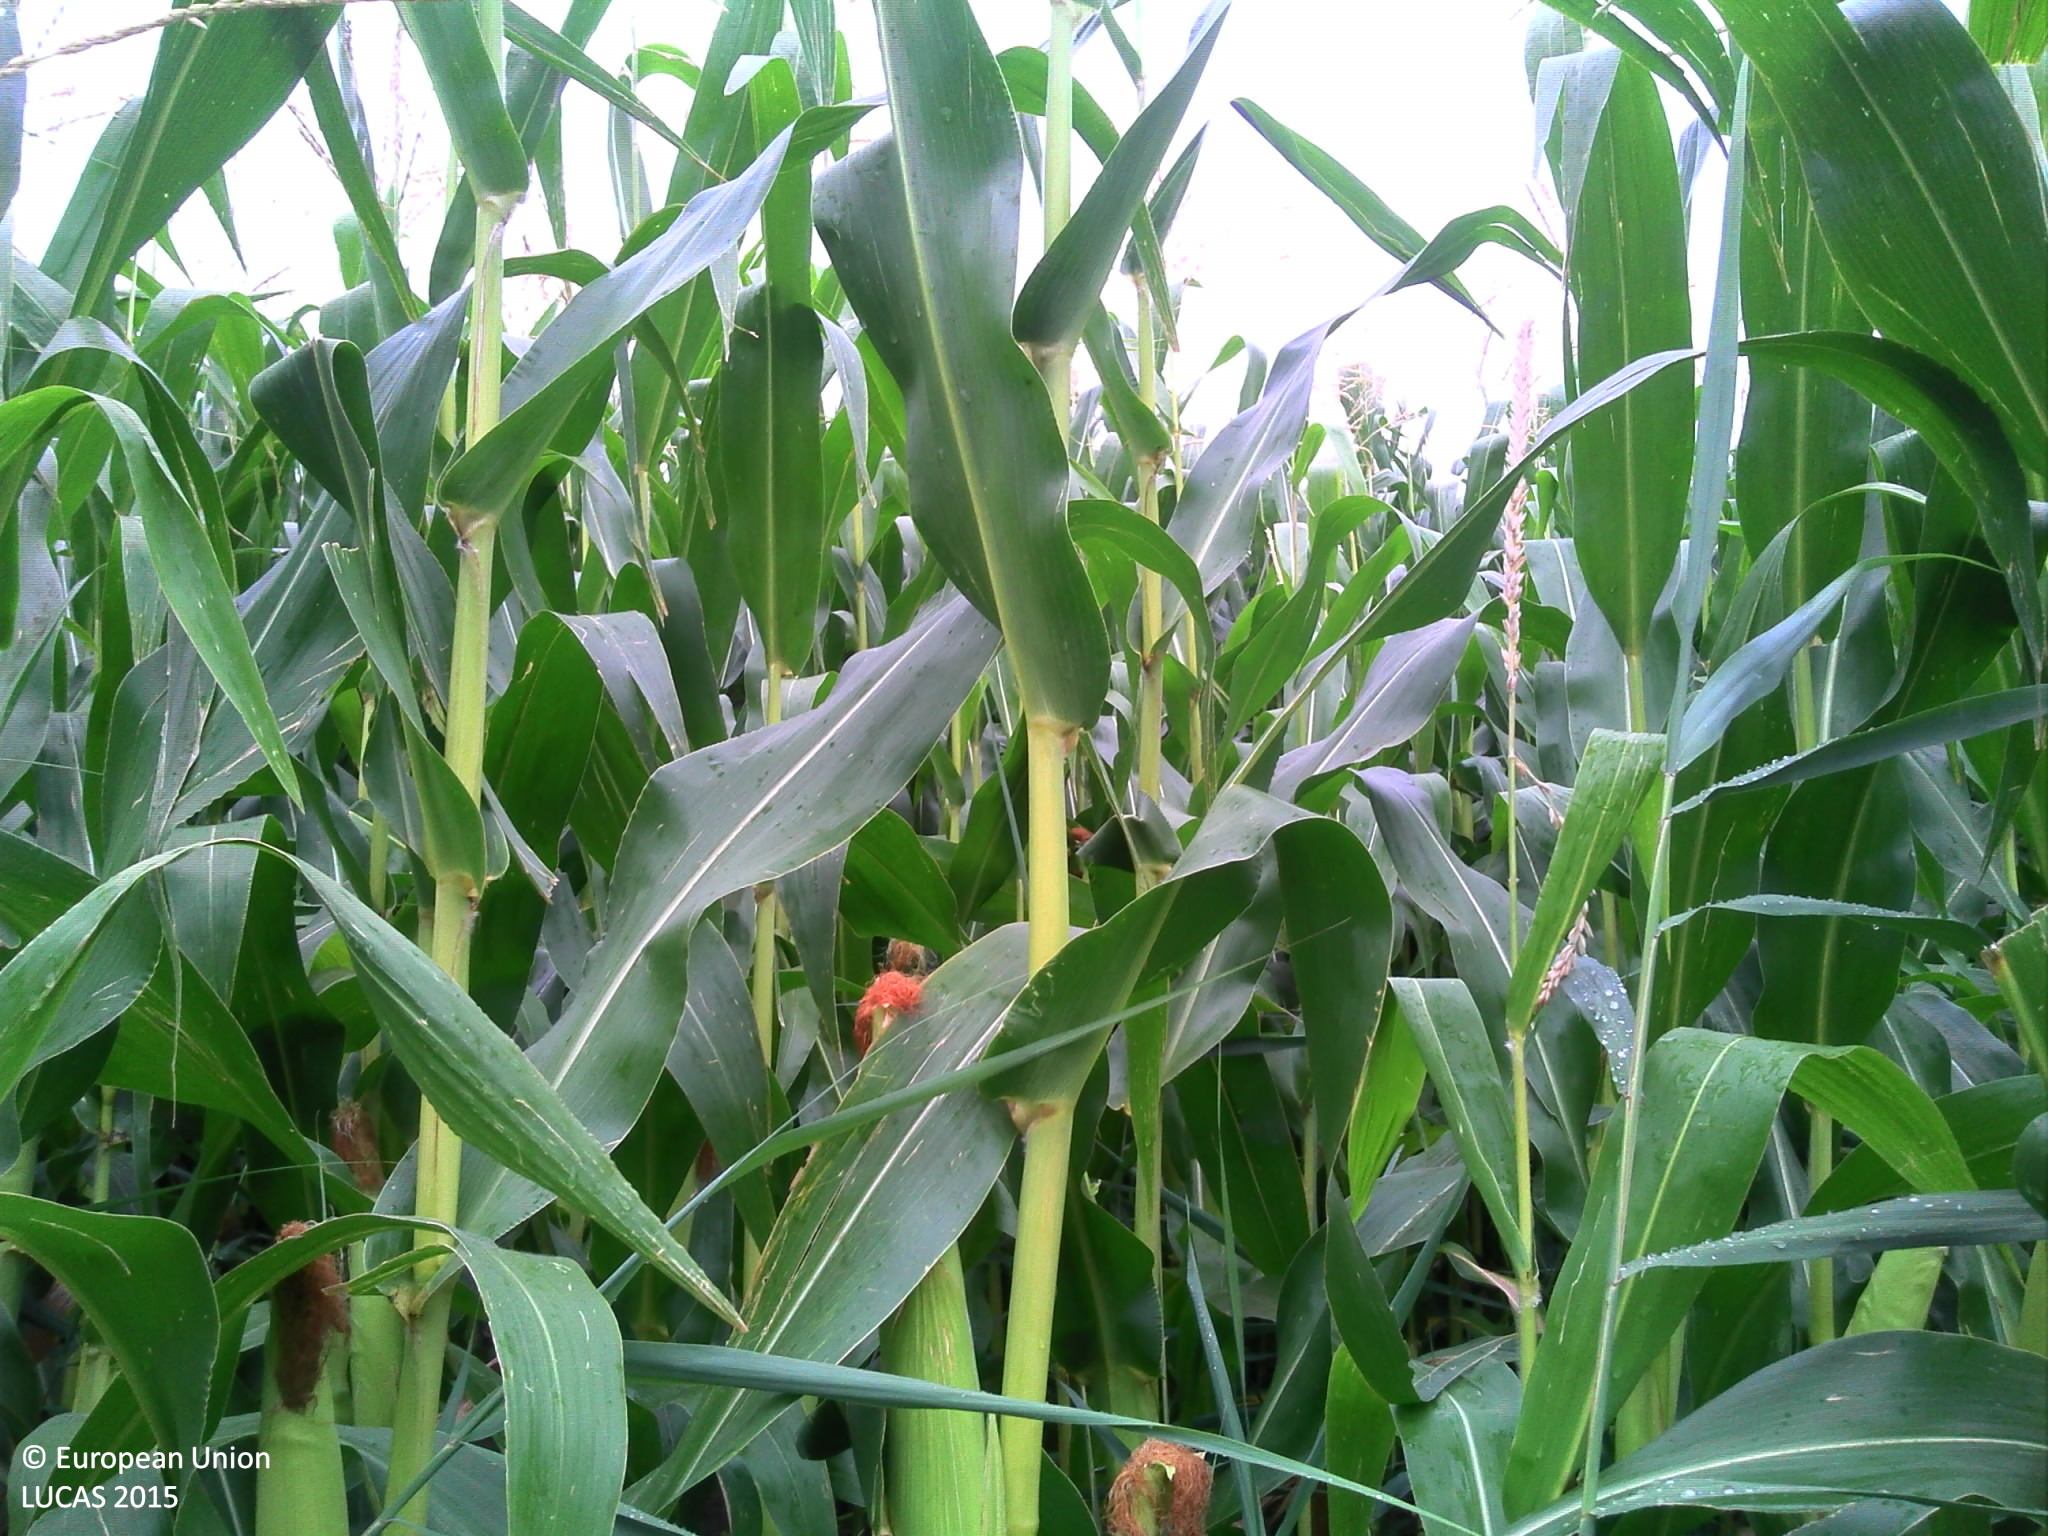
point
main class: Cropland
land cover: Maize
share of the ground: > 75 %
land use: Agriculture (excluding fallow land and kitchen gardens)
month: August
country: FR
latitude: 48.9262
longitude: 8.0489
